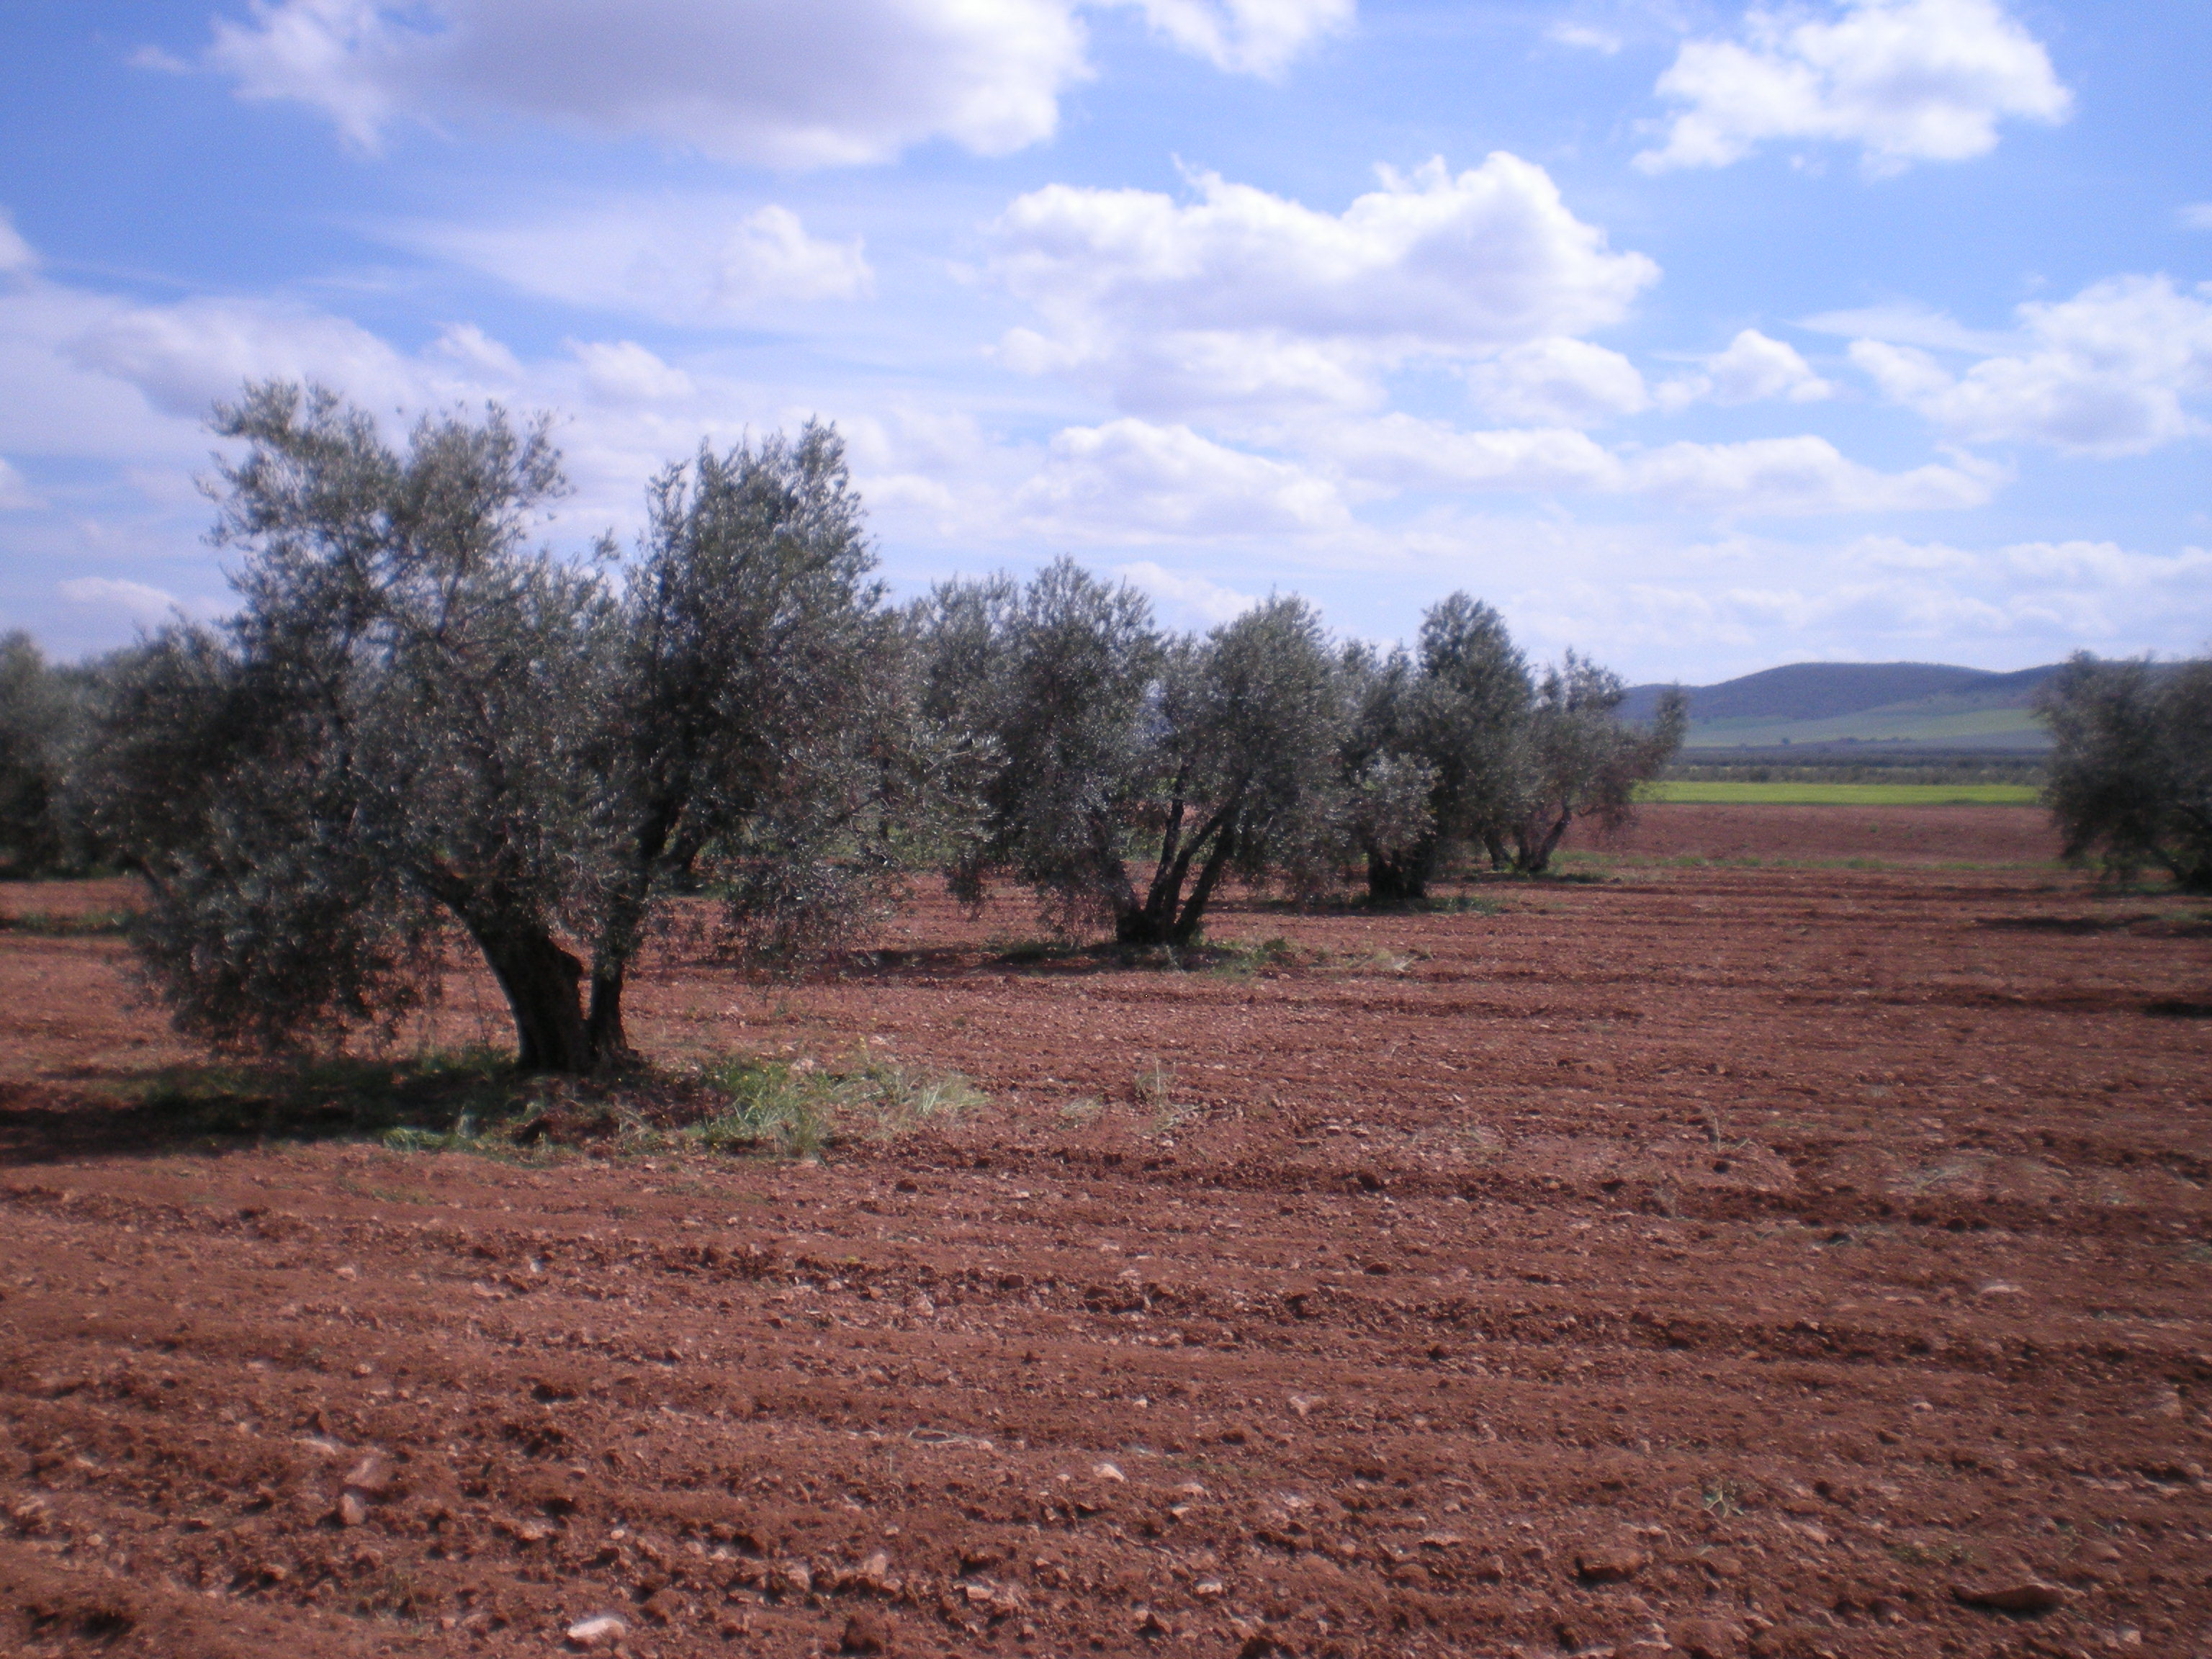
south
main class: Cropland
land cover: Olive groves
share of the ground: 10 - 25 %
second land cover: Other bare soil
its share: > 75 %
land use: Agriculture (excluding fallow land and kitchen gardens)
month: April
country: ES
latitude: 38.6676
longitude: -3.5154
